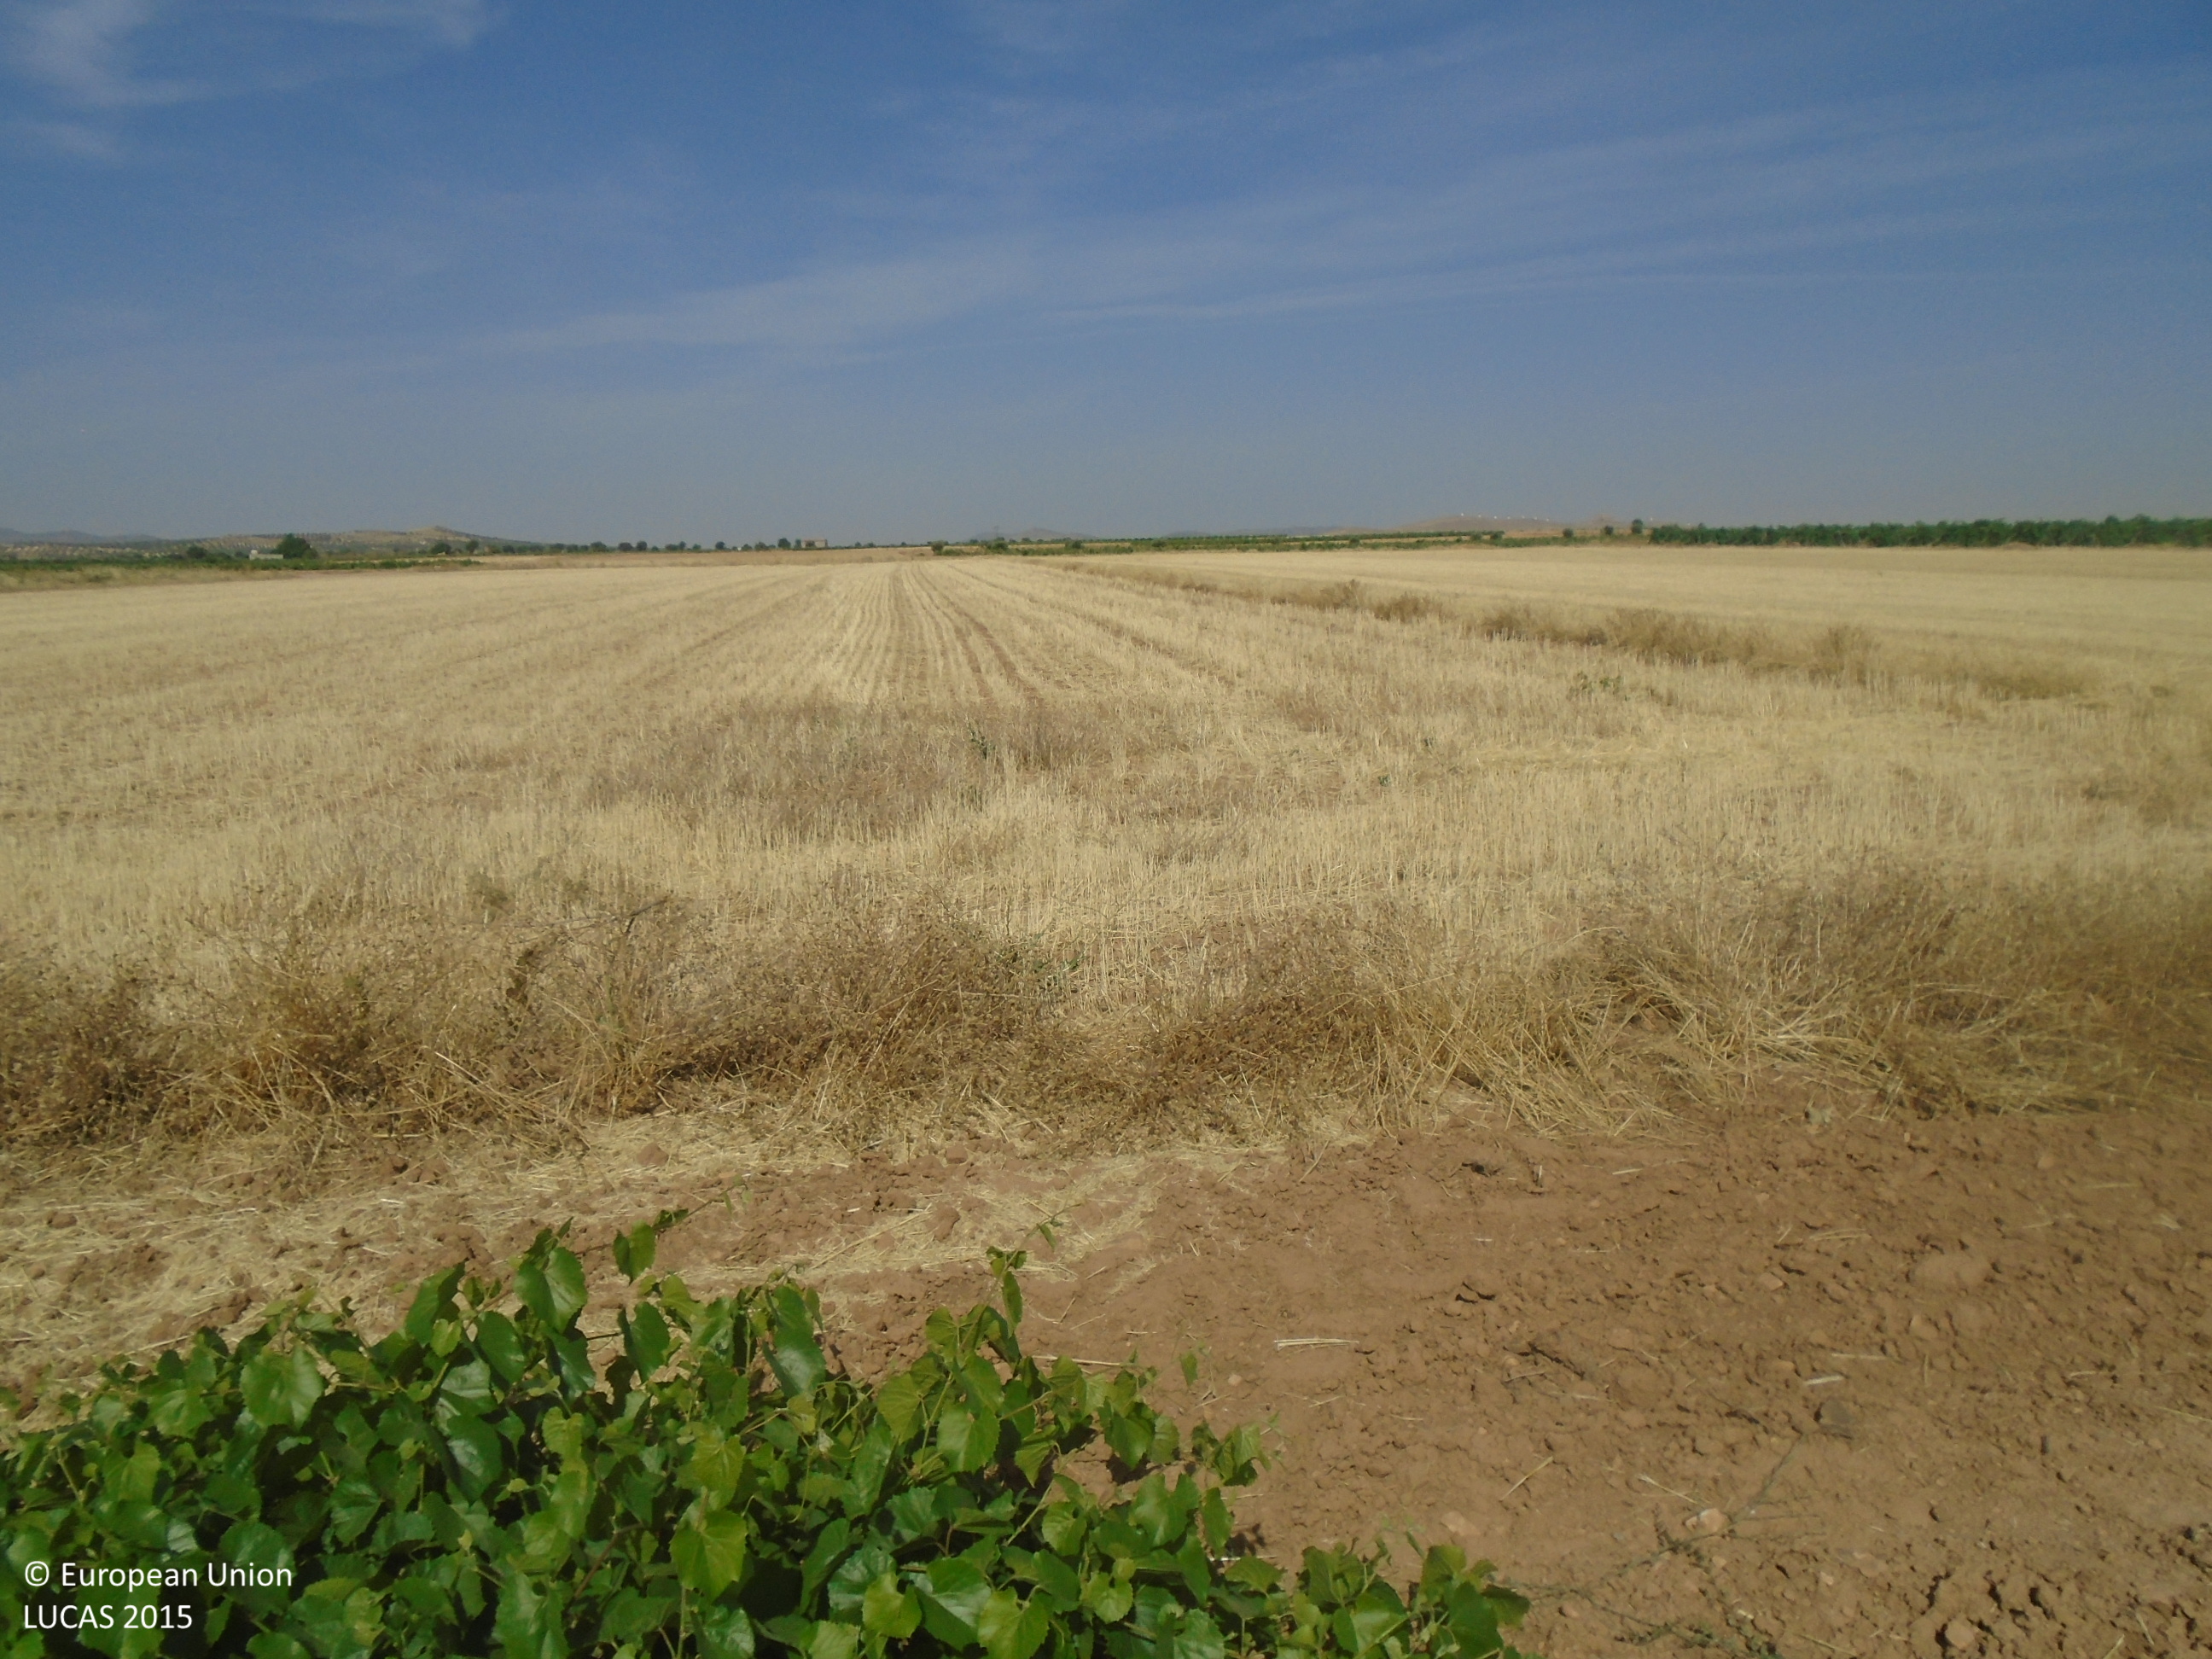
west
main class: Cropland
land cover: Vineyards
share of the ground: 10 - 25 %
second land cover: Other bare soil
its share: > 75 %
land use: Agriculture (excluding fallow land and kitchen gardens)
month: July
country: ES
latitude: 39.4347
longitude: -3.5340
